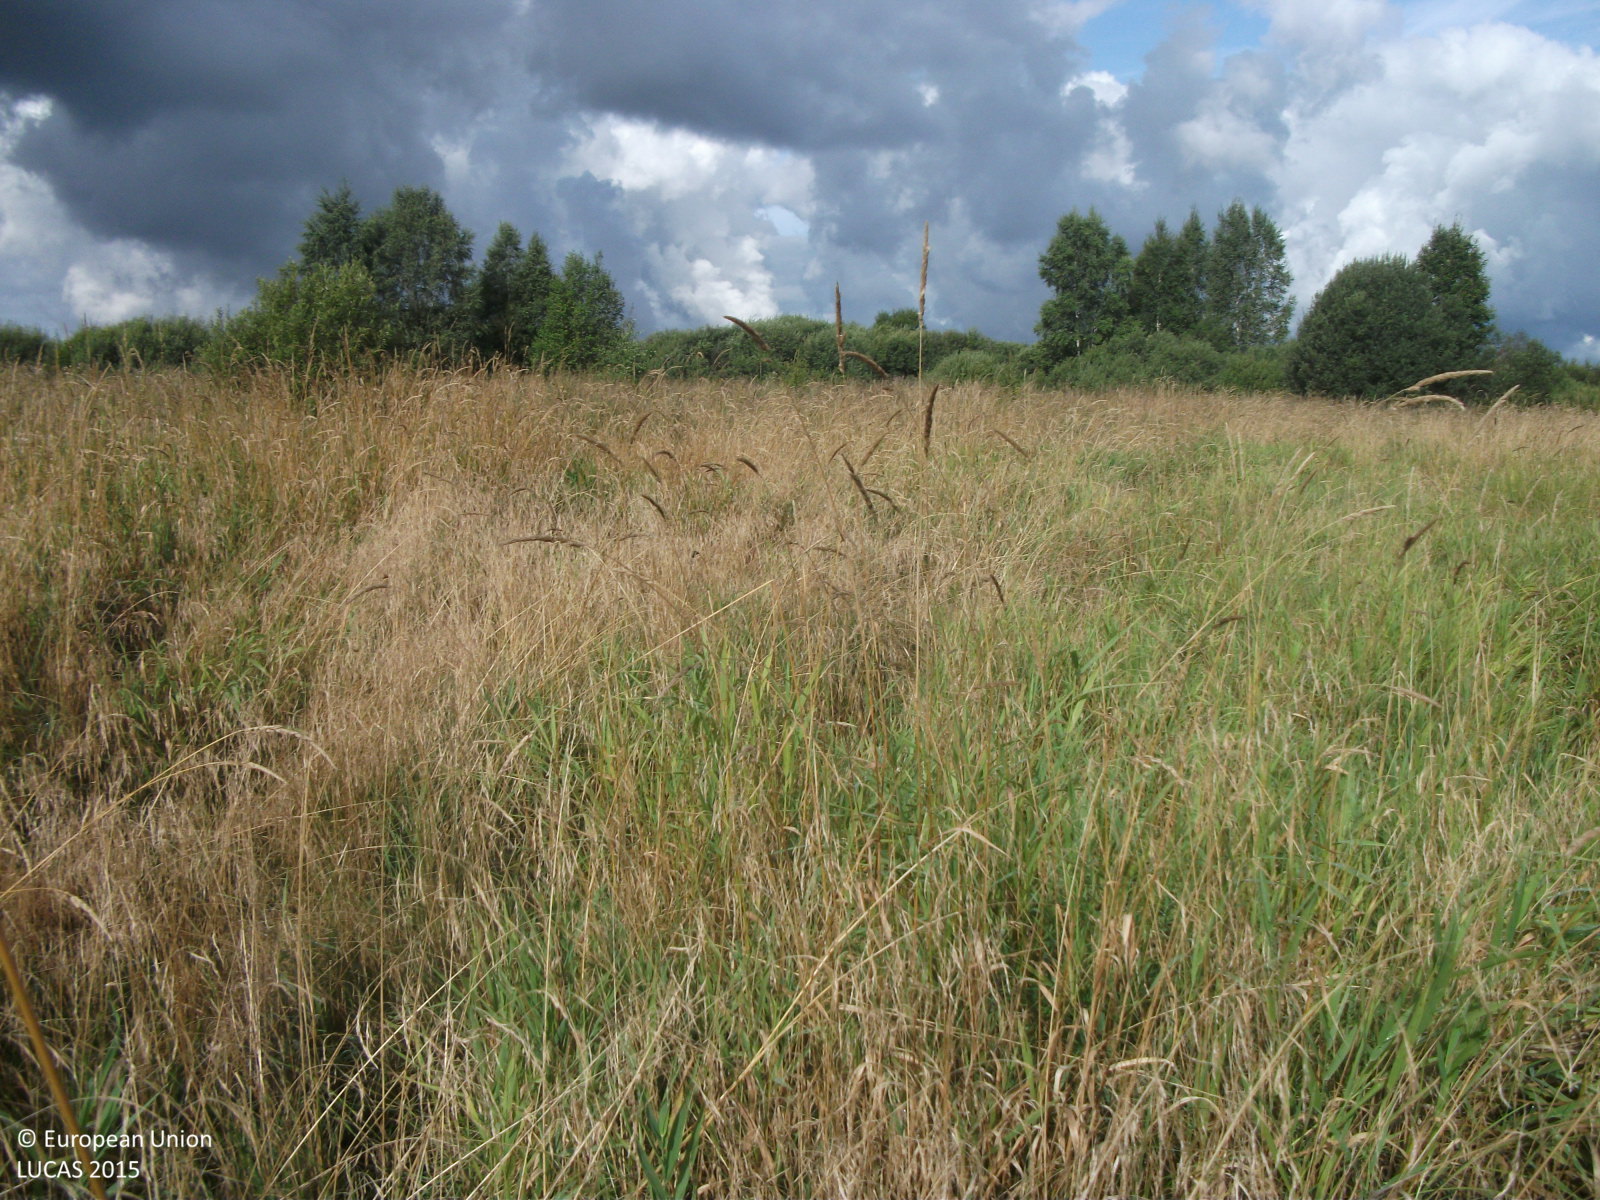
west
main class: Grassland
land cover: Spontaneously vegetated surfaces
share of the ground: > 75 %
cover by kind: herbaceous plants 95 %, shrubs 5 %
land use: Semi-natural and natural areas not in use
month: September
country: LV
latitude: 57.5846
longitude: 24.7310
